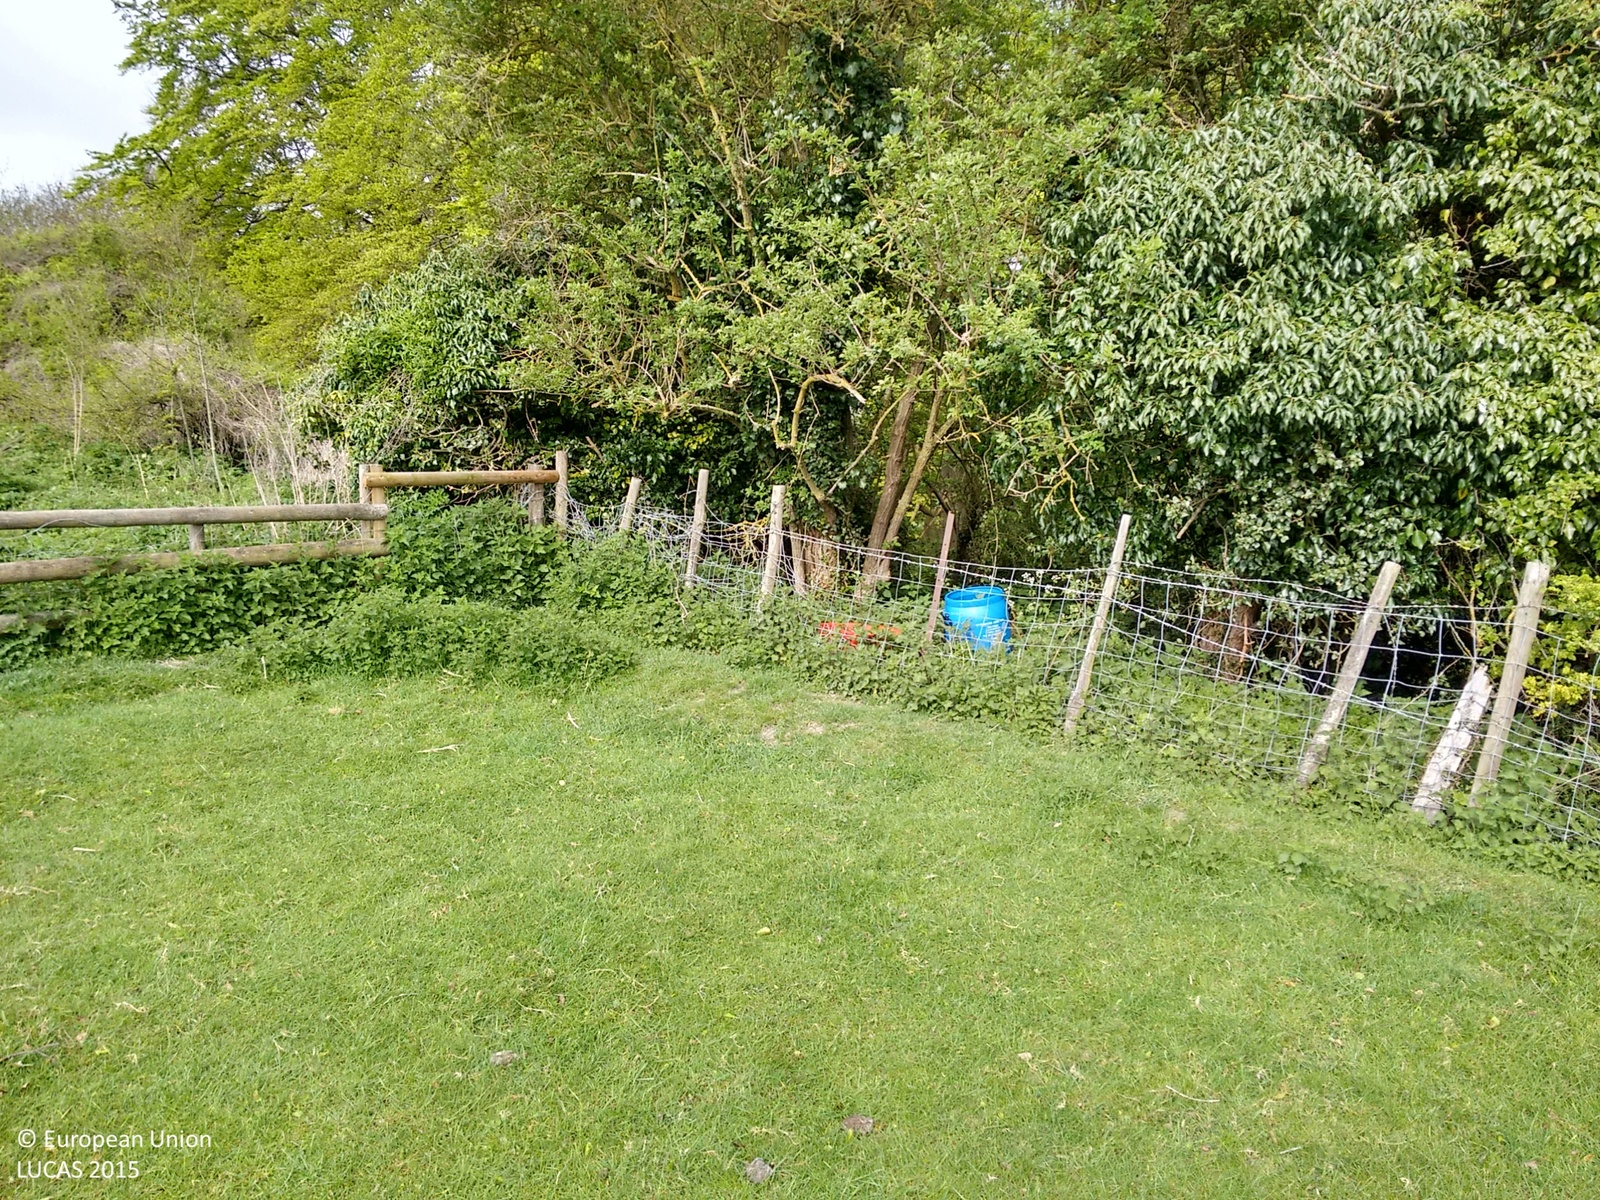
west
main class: Grassland
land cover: Grassland without tree/shrub cover
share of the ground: > 75 %
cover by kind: herbaceous plants 100 %
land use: Agriculture (excluding fallow land and kitchen gardens)
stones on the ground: < 10 %
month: May
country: GB
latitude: 51.8451
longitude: -0.6217
